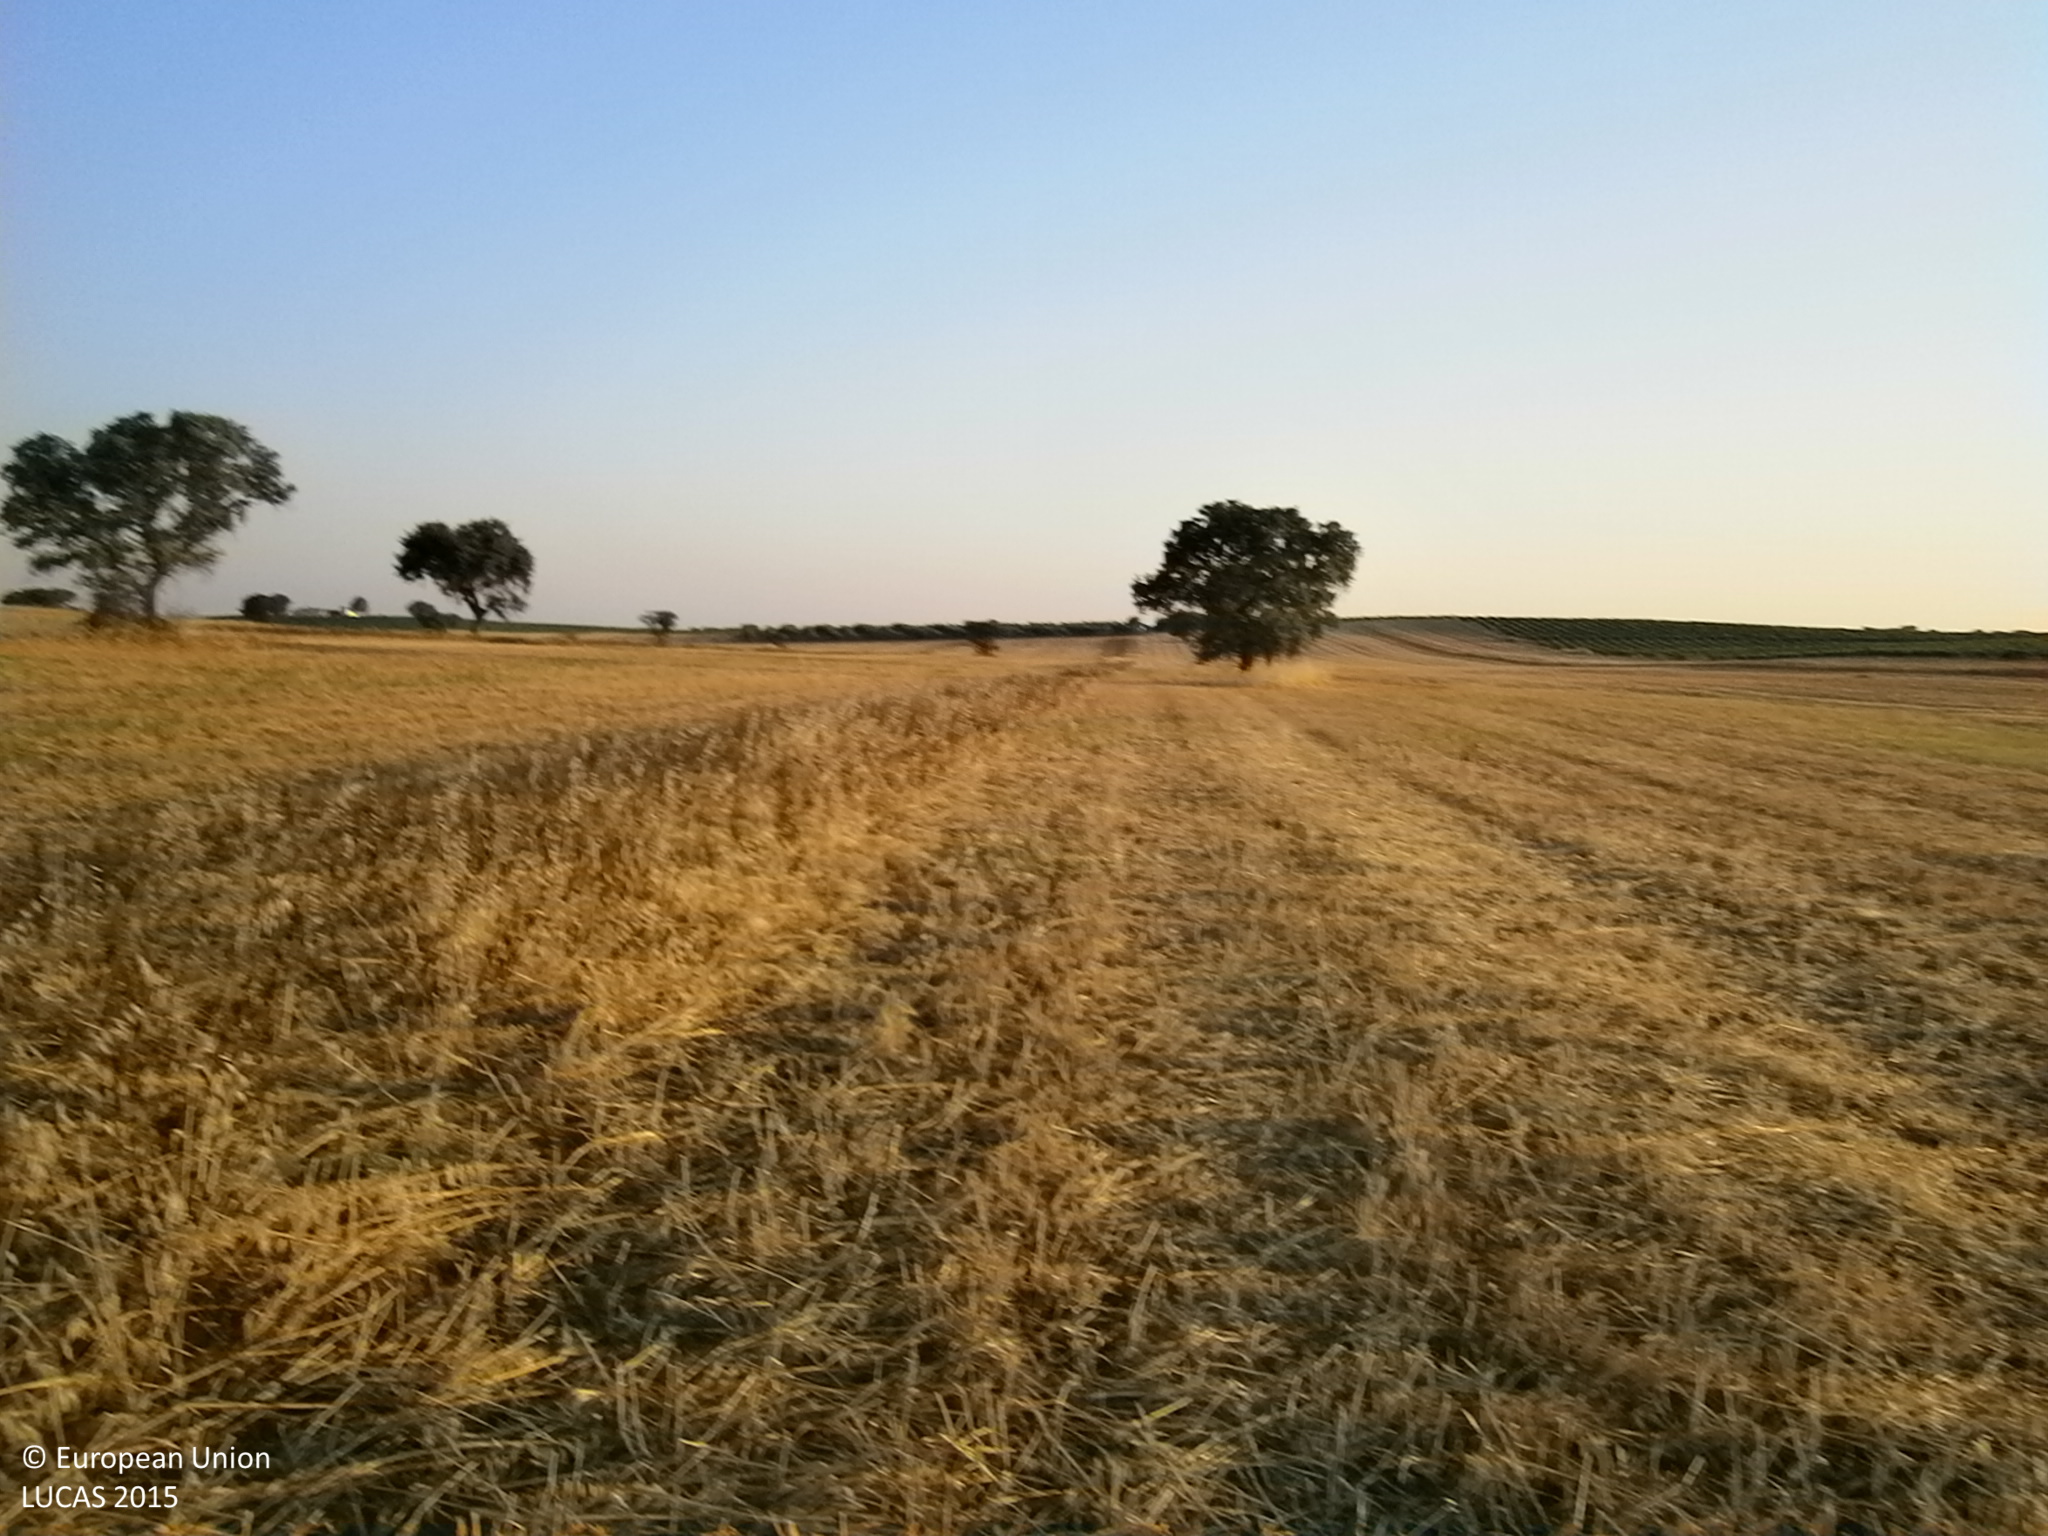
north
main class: Cropland
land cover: Oats
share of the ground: > 75 %
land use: Agriculture (excluding fallow land and kitchen gardens)
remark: Harvested field
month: June
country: ES
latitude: 38.7232
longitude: -6.7518
